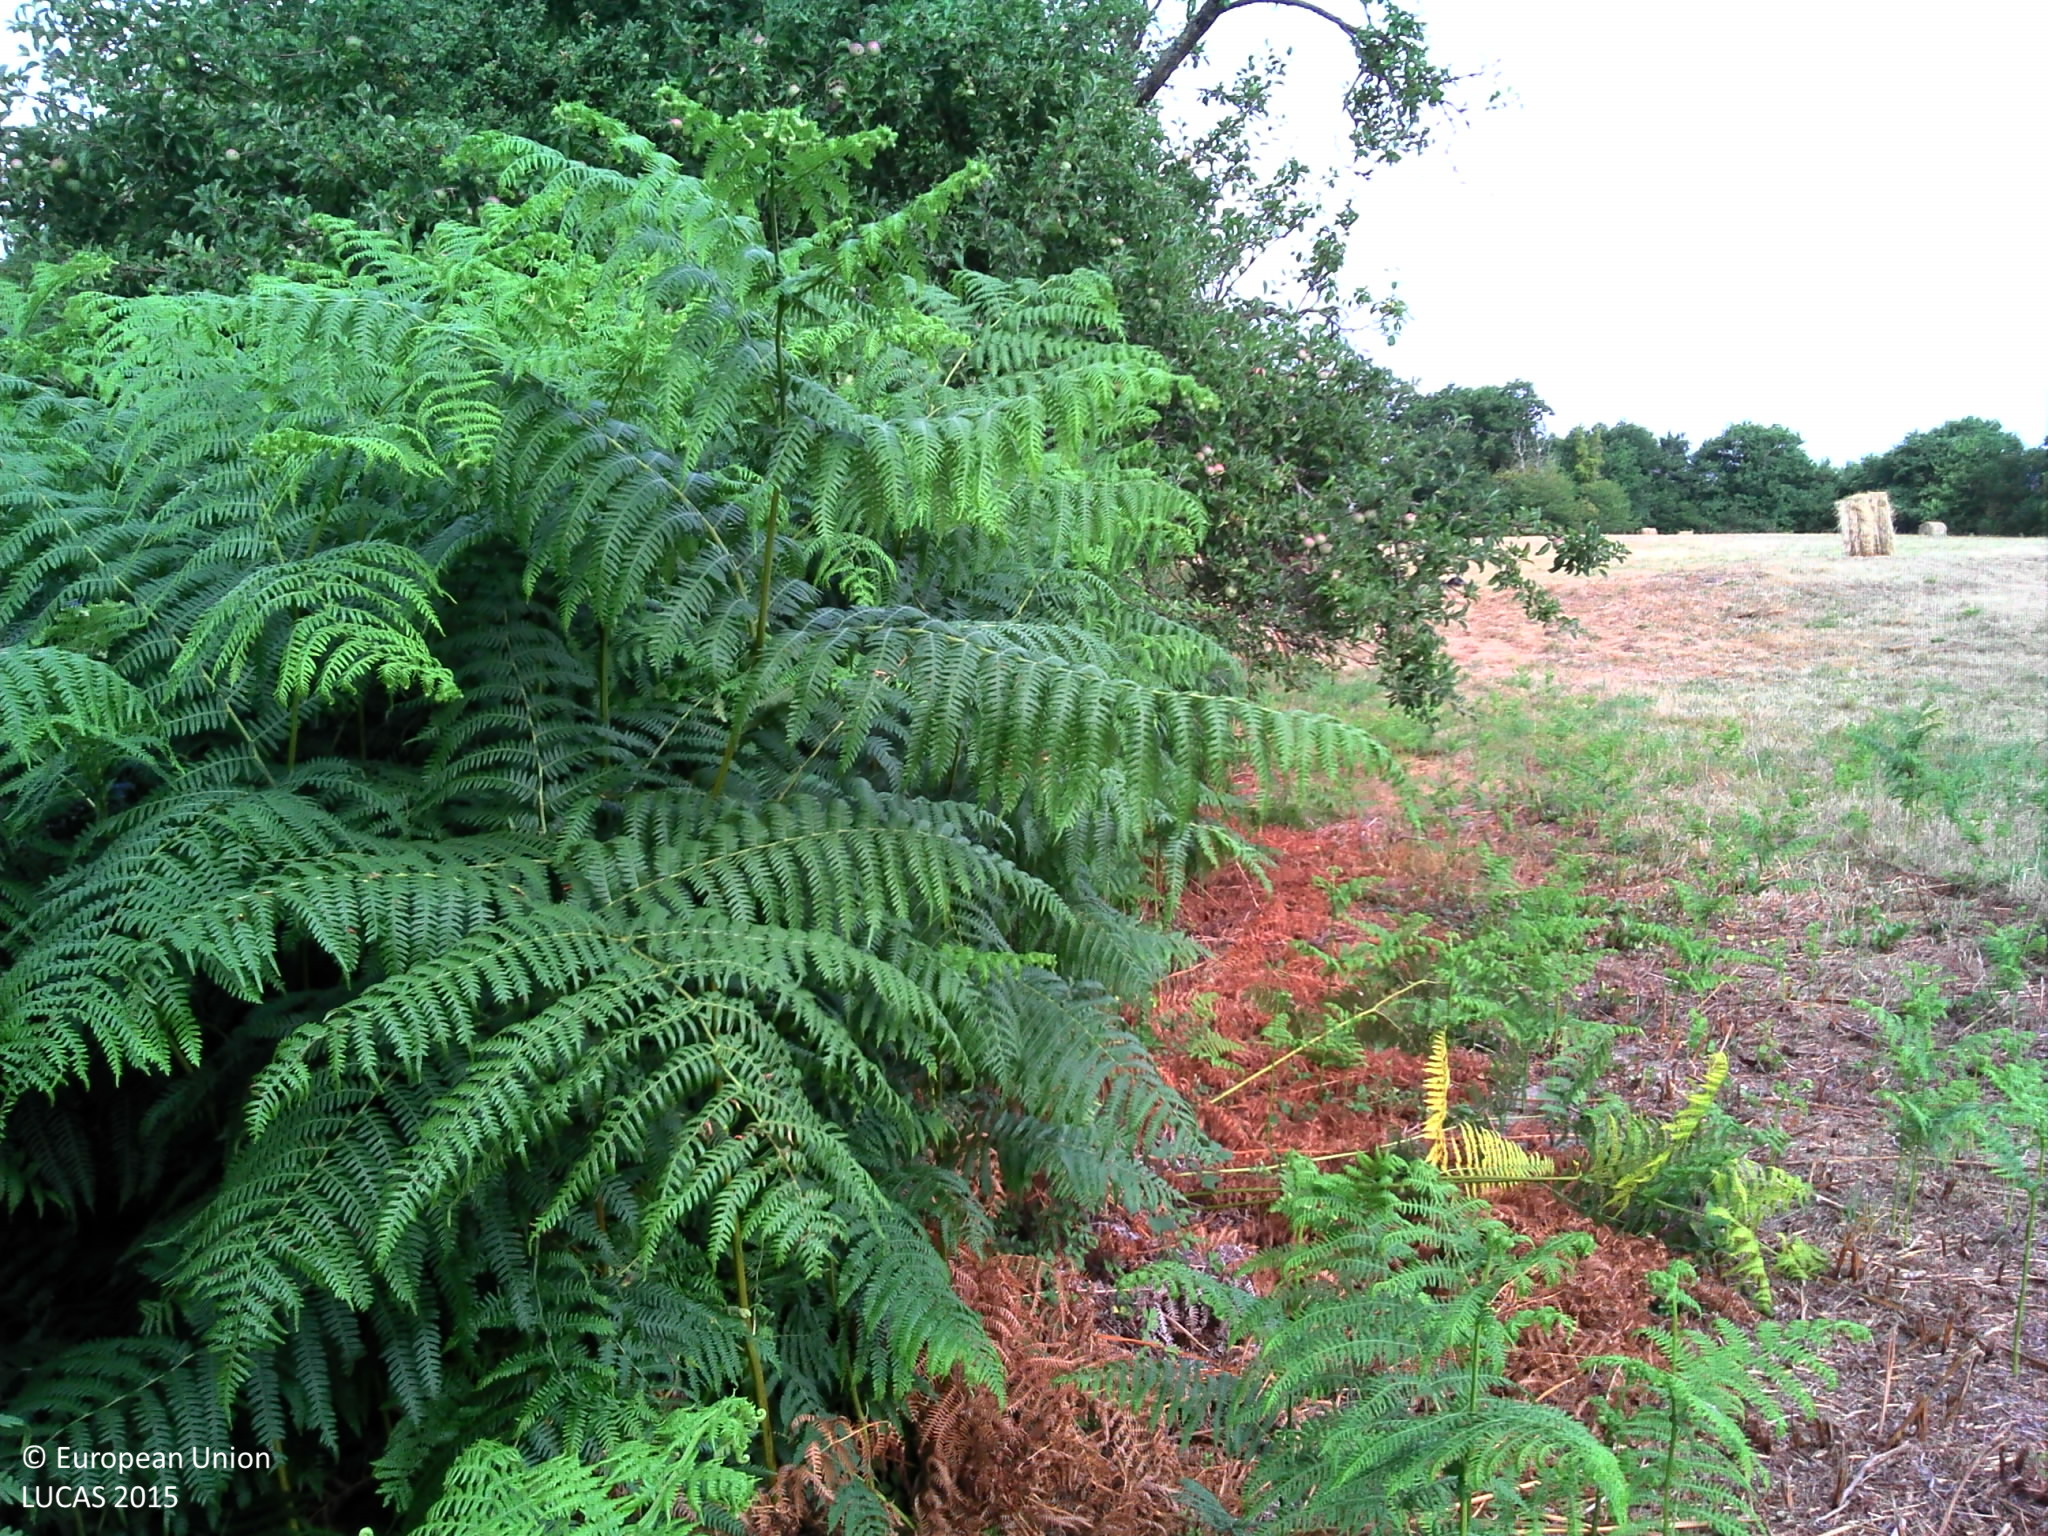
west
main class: Grassland
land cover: Grassland without tree/shrub cover
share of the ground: > 75 %
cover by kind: herbaceous plants 95 %
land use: Agriculture (excluding fallow land and kitchen gardens)
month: July
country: FR
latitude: 45.8455
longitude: 1.0141
